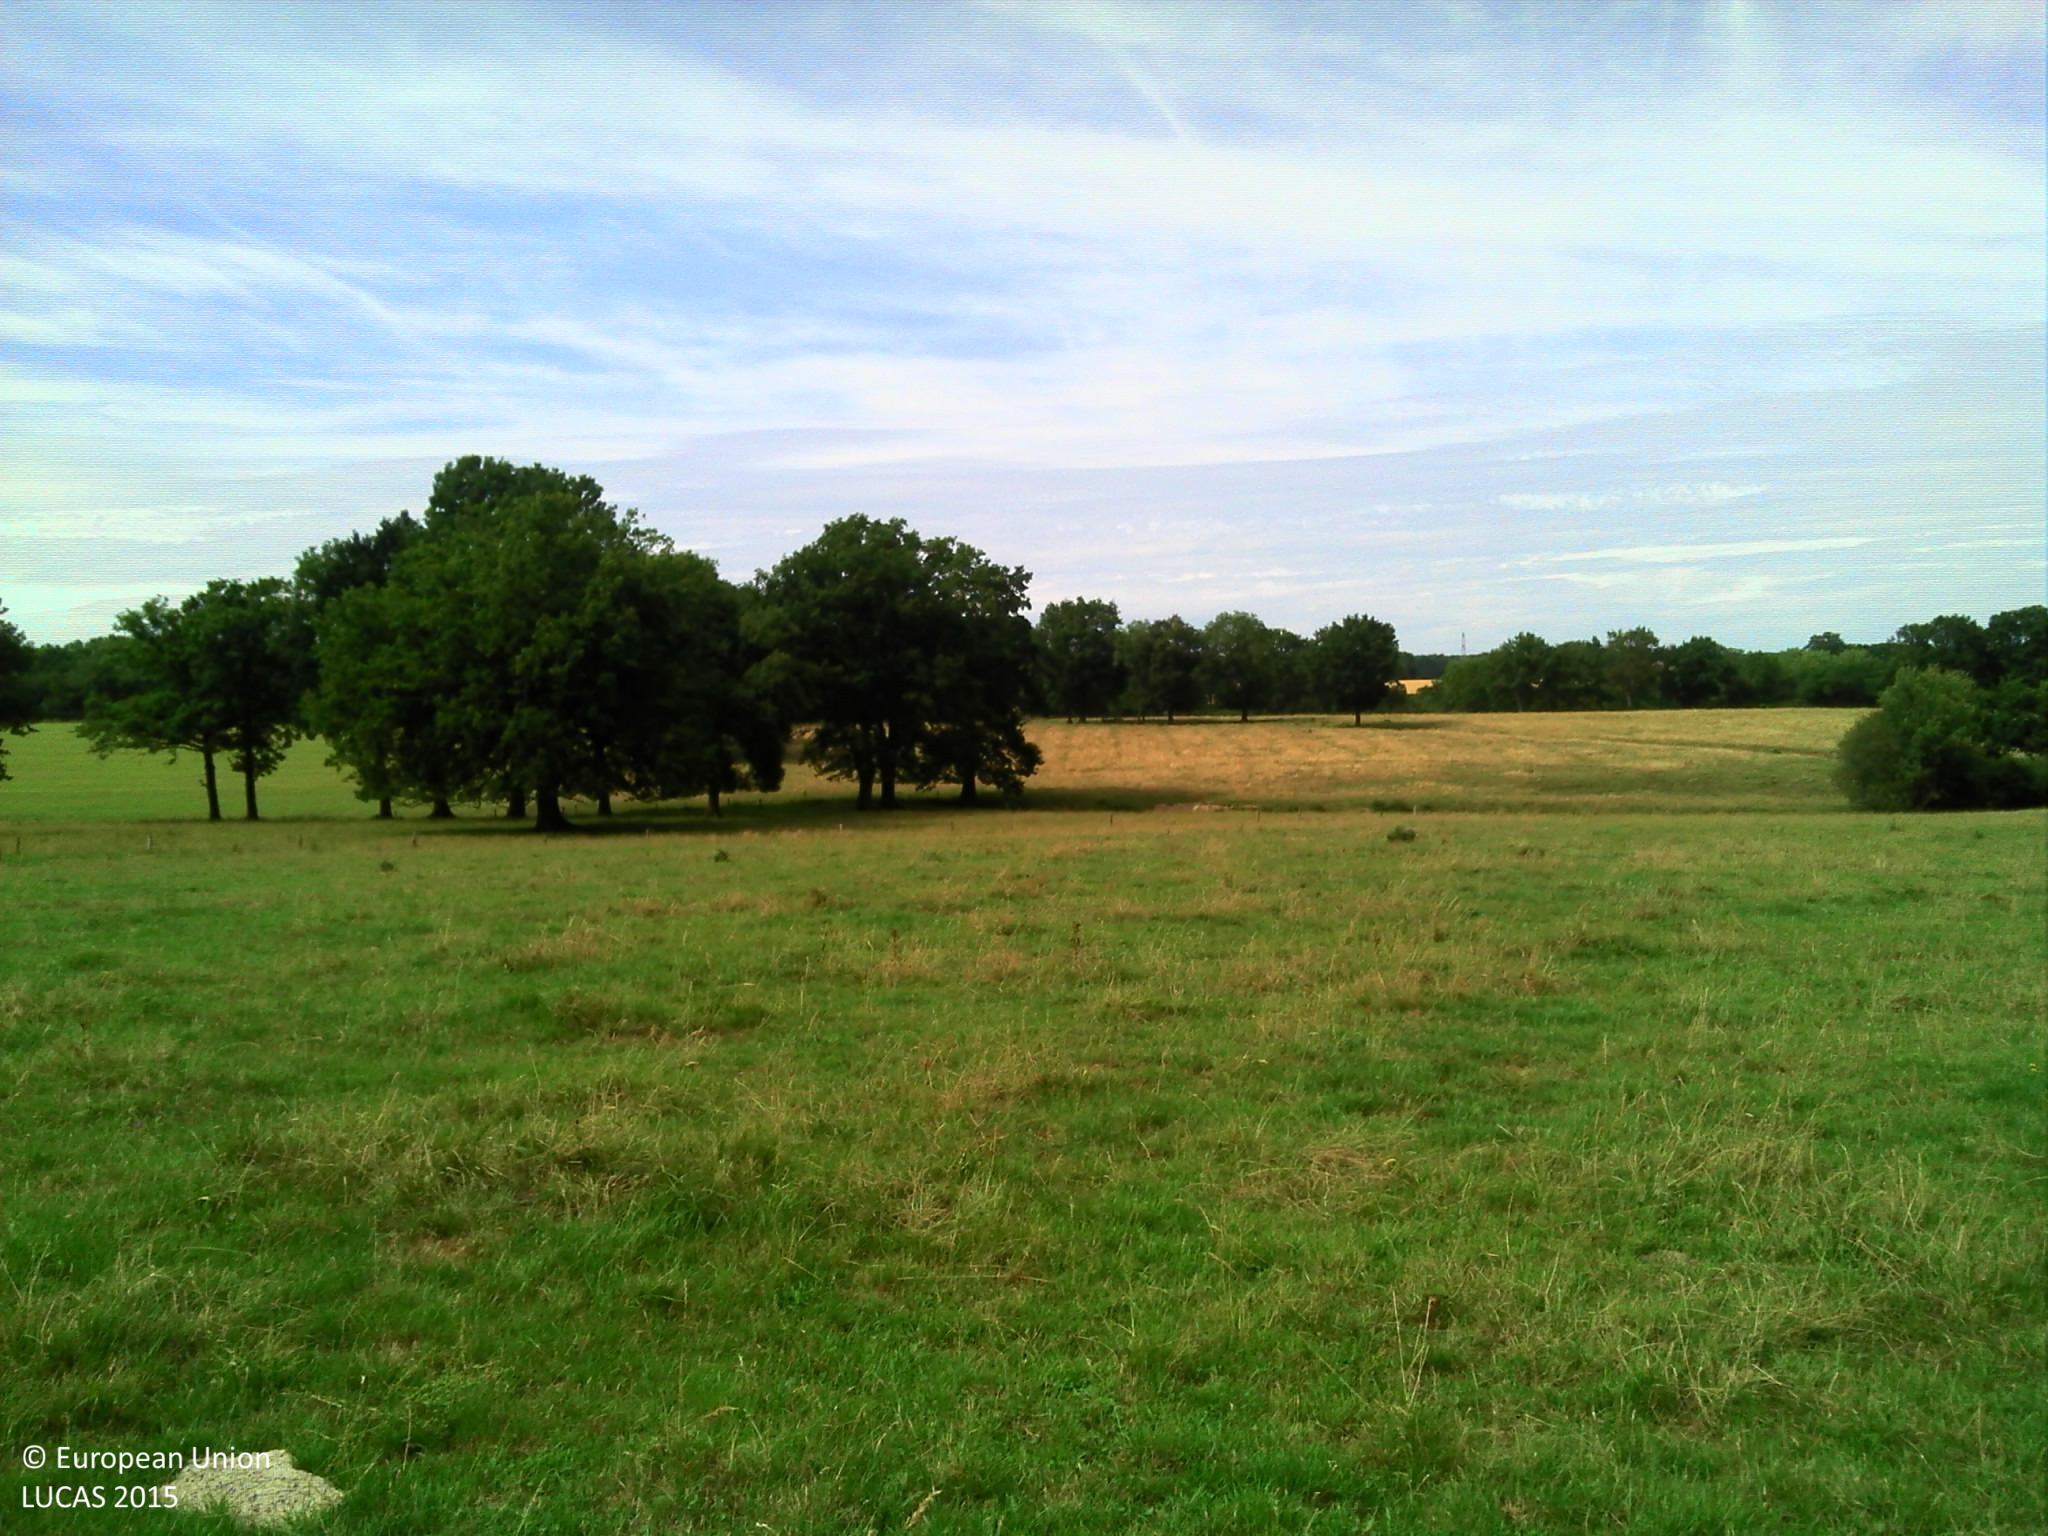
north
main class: Grassland
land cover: Grassland without tree/shrub cover
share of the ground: > 75 %
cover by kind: herbaceous plants 100 %
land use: Agriculture (excluding fallow land and kitchen gardens)
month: June
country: FR
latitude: 46.4805
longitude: 3.2378
